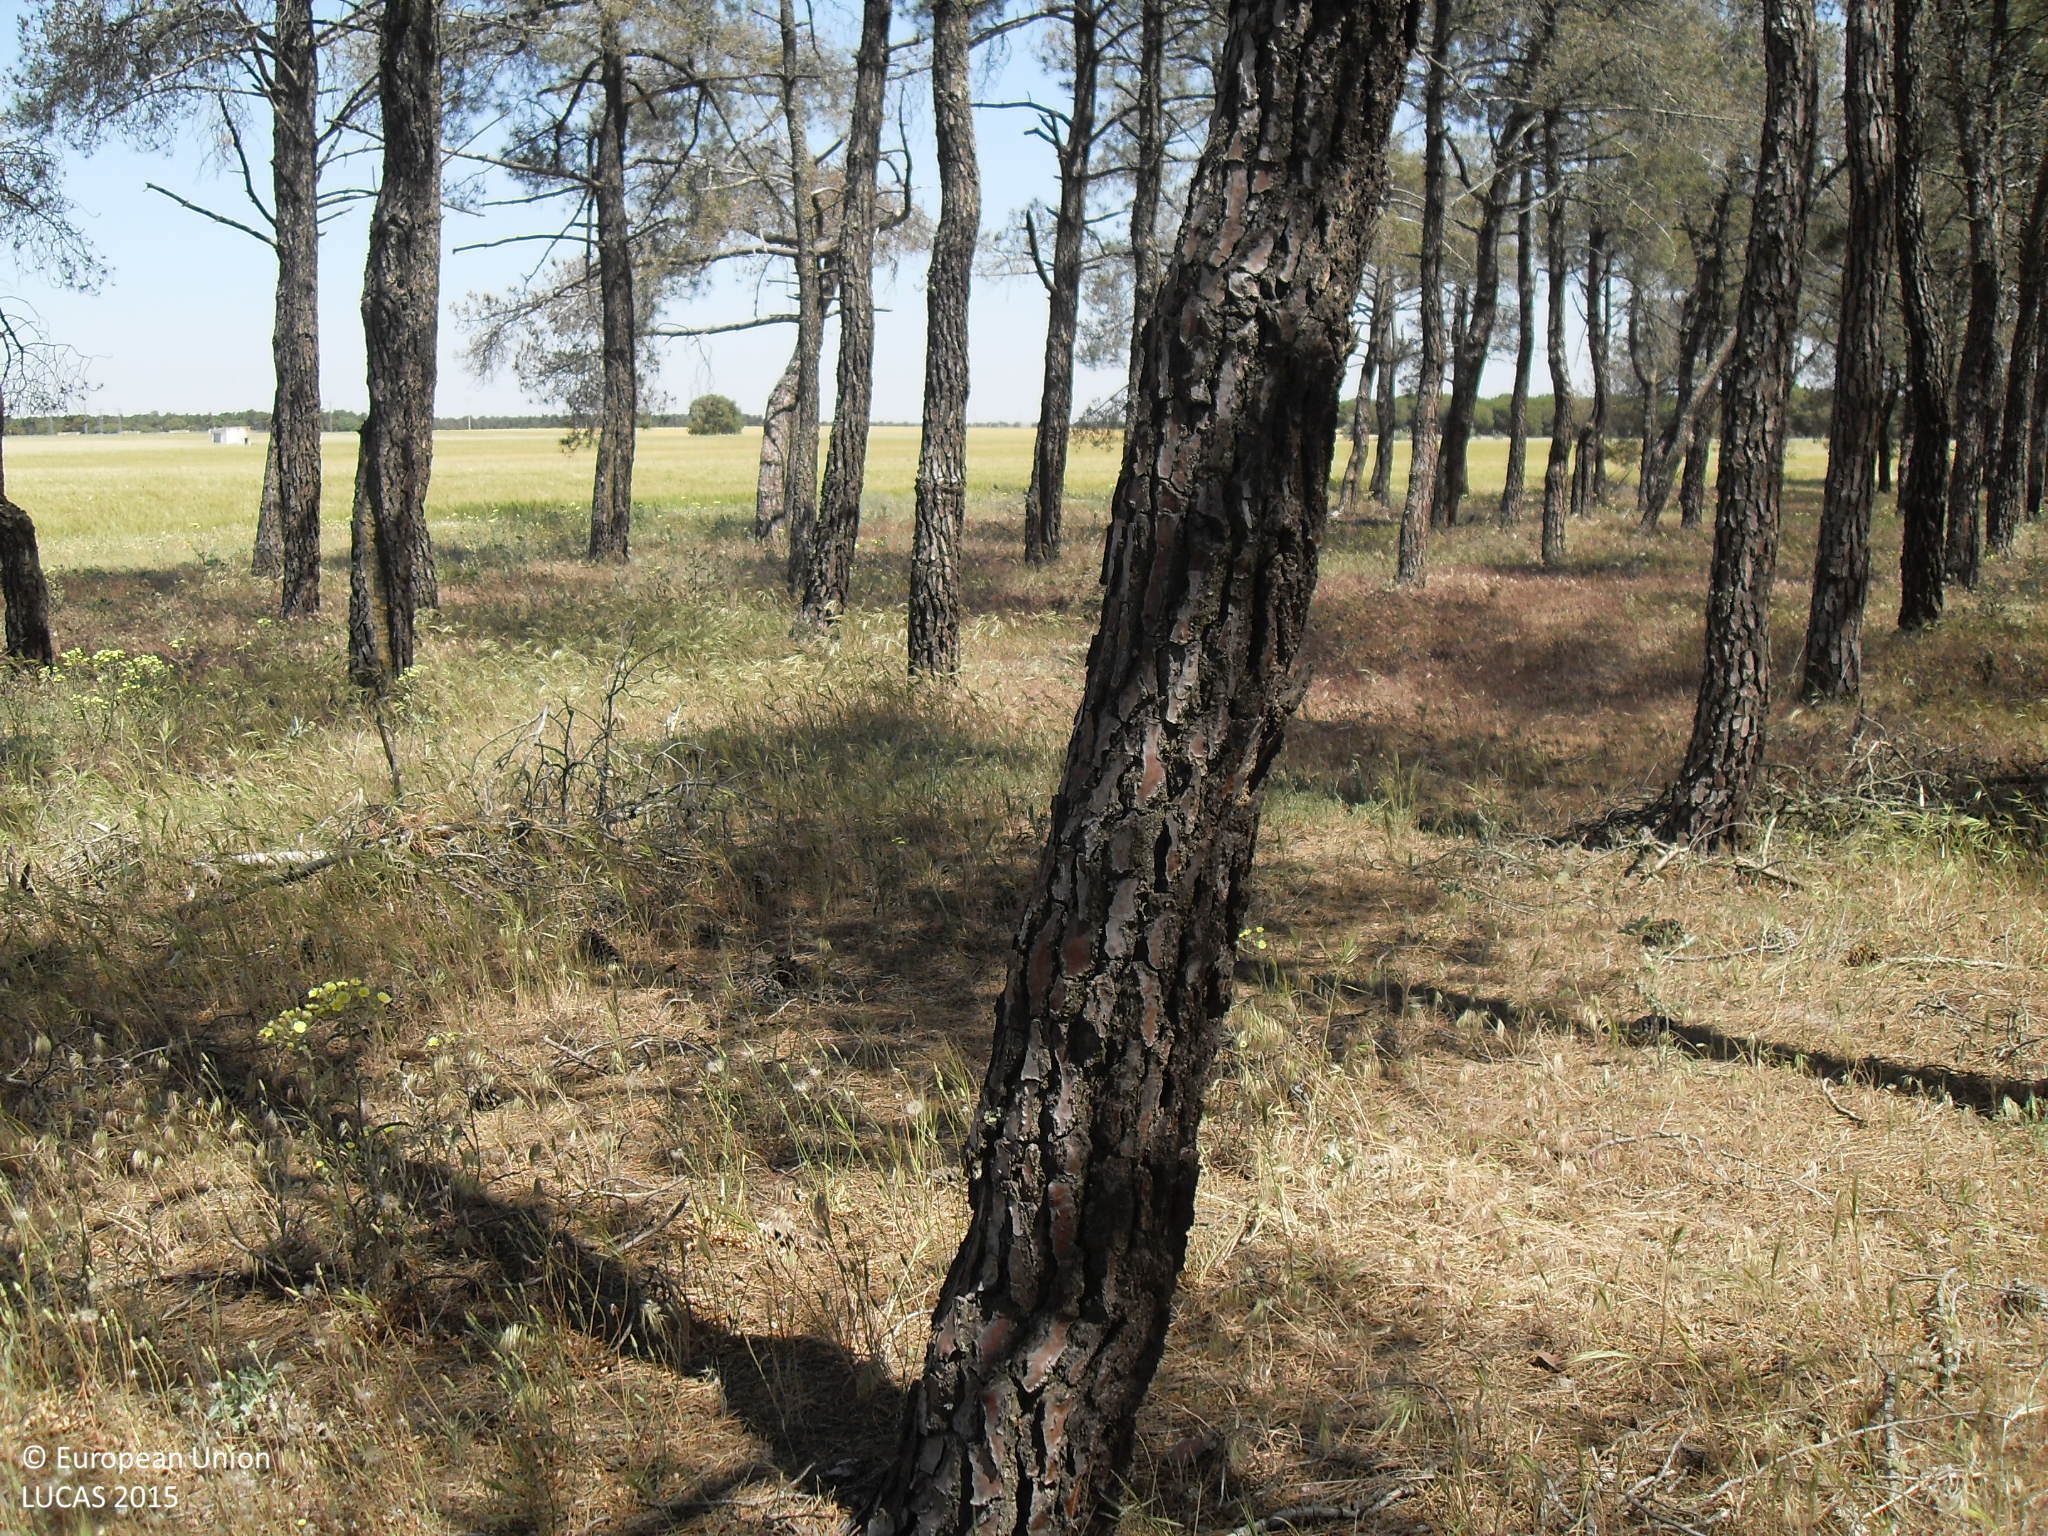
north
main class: Woodland
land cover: Pine dominated coniferous woodland
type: coniferous forest of the mediterranean region
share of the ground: > 75 %
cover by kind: coniferous forest trees 100 %
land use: Forestry
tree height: > 5 m
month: May
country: ES
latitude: 41.1166
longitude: -5.0621
